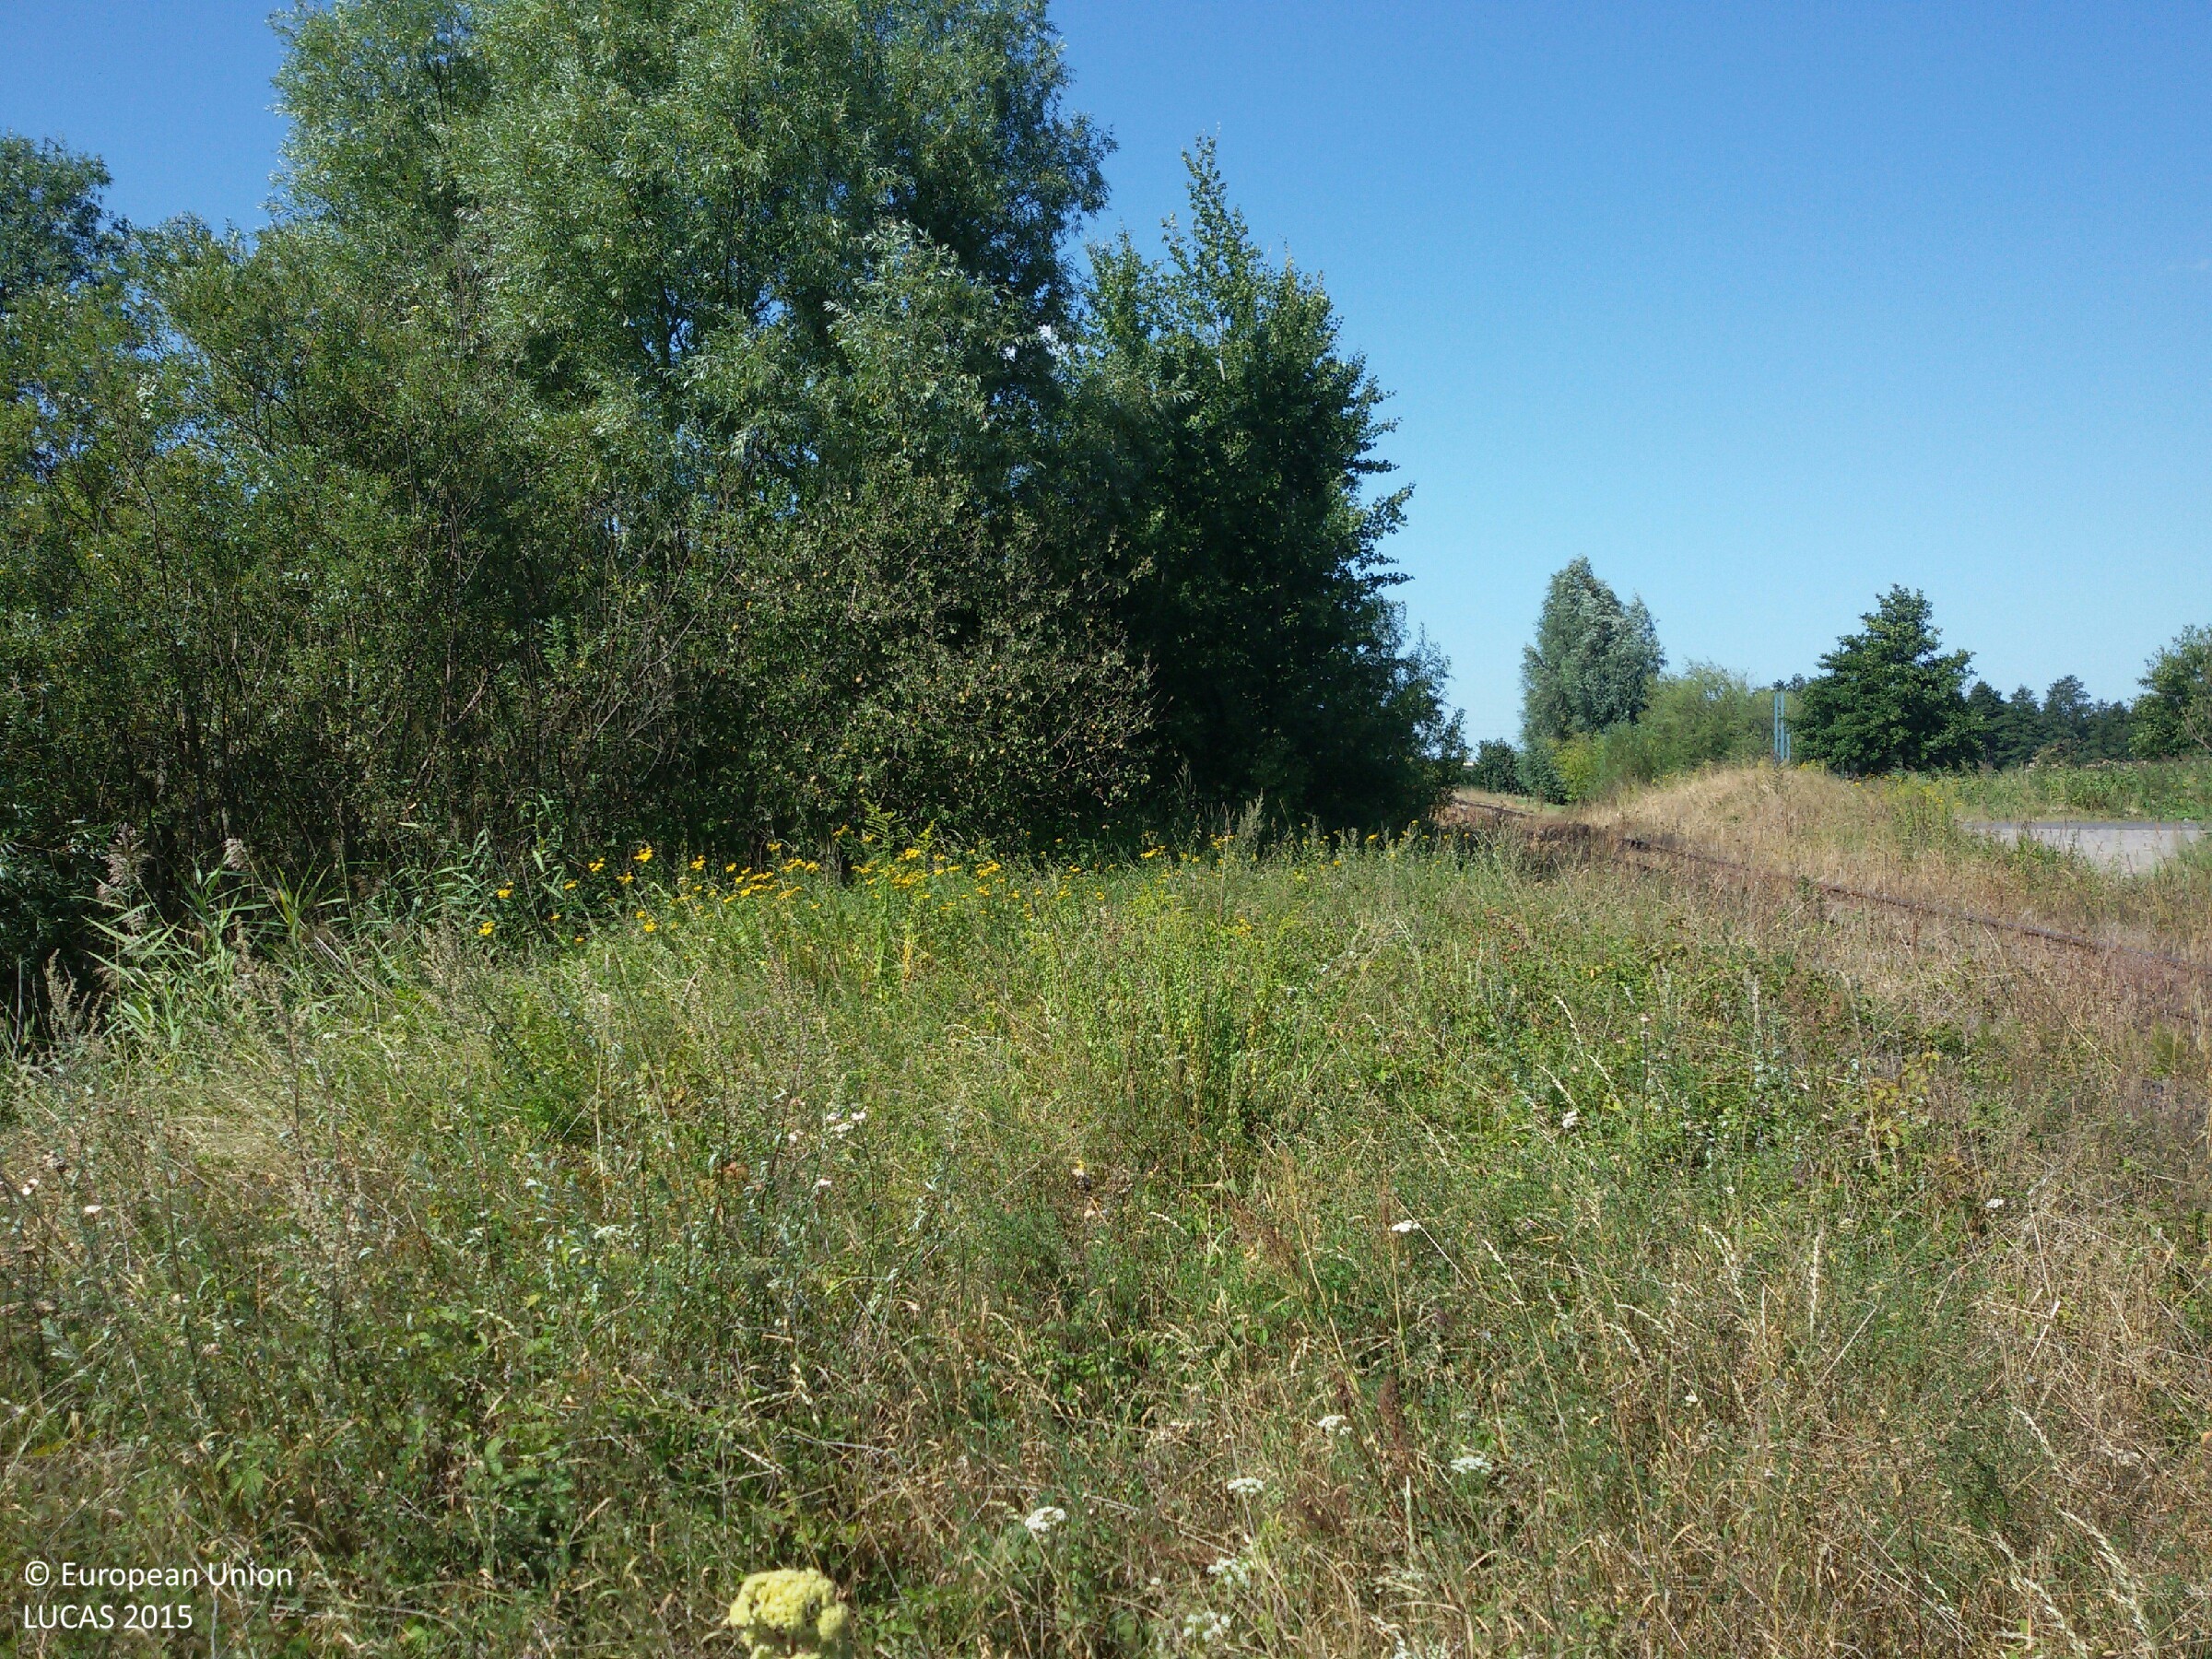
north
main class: Grassland
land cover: Spontaneously vegetated surfaces
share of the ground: > 75 %
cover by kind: herbaceous plants 95 %, shrubs 5 %
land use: Semi-natural and natural areas not in use
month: August
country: PL
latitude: 54.1417
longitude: 19.3777
